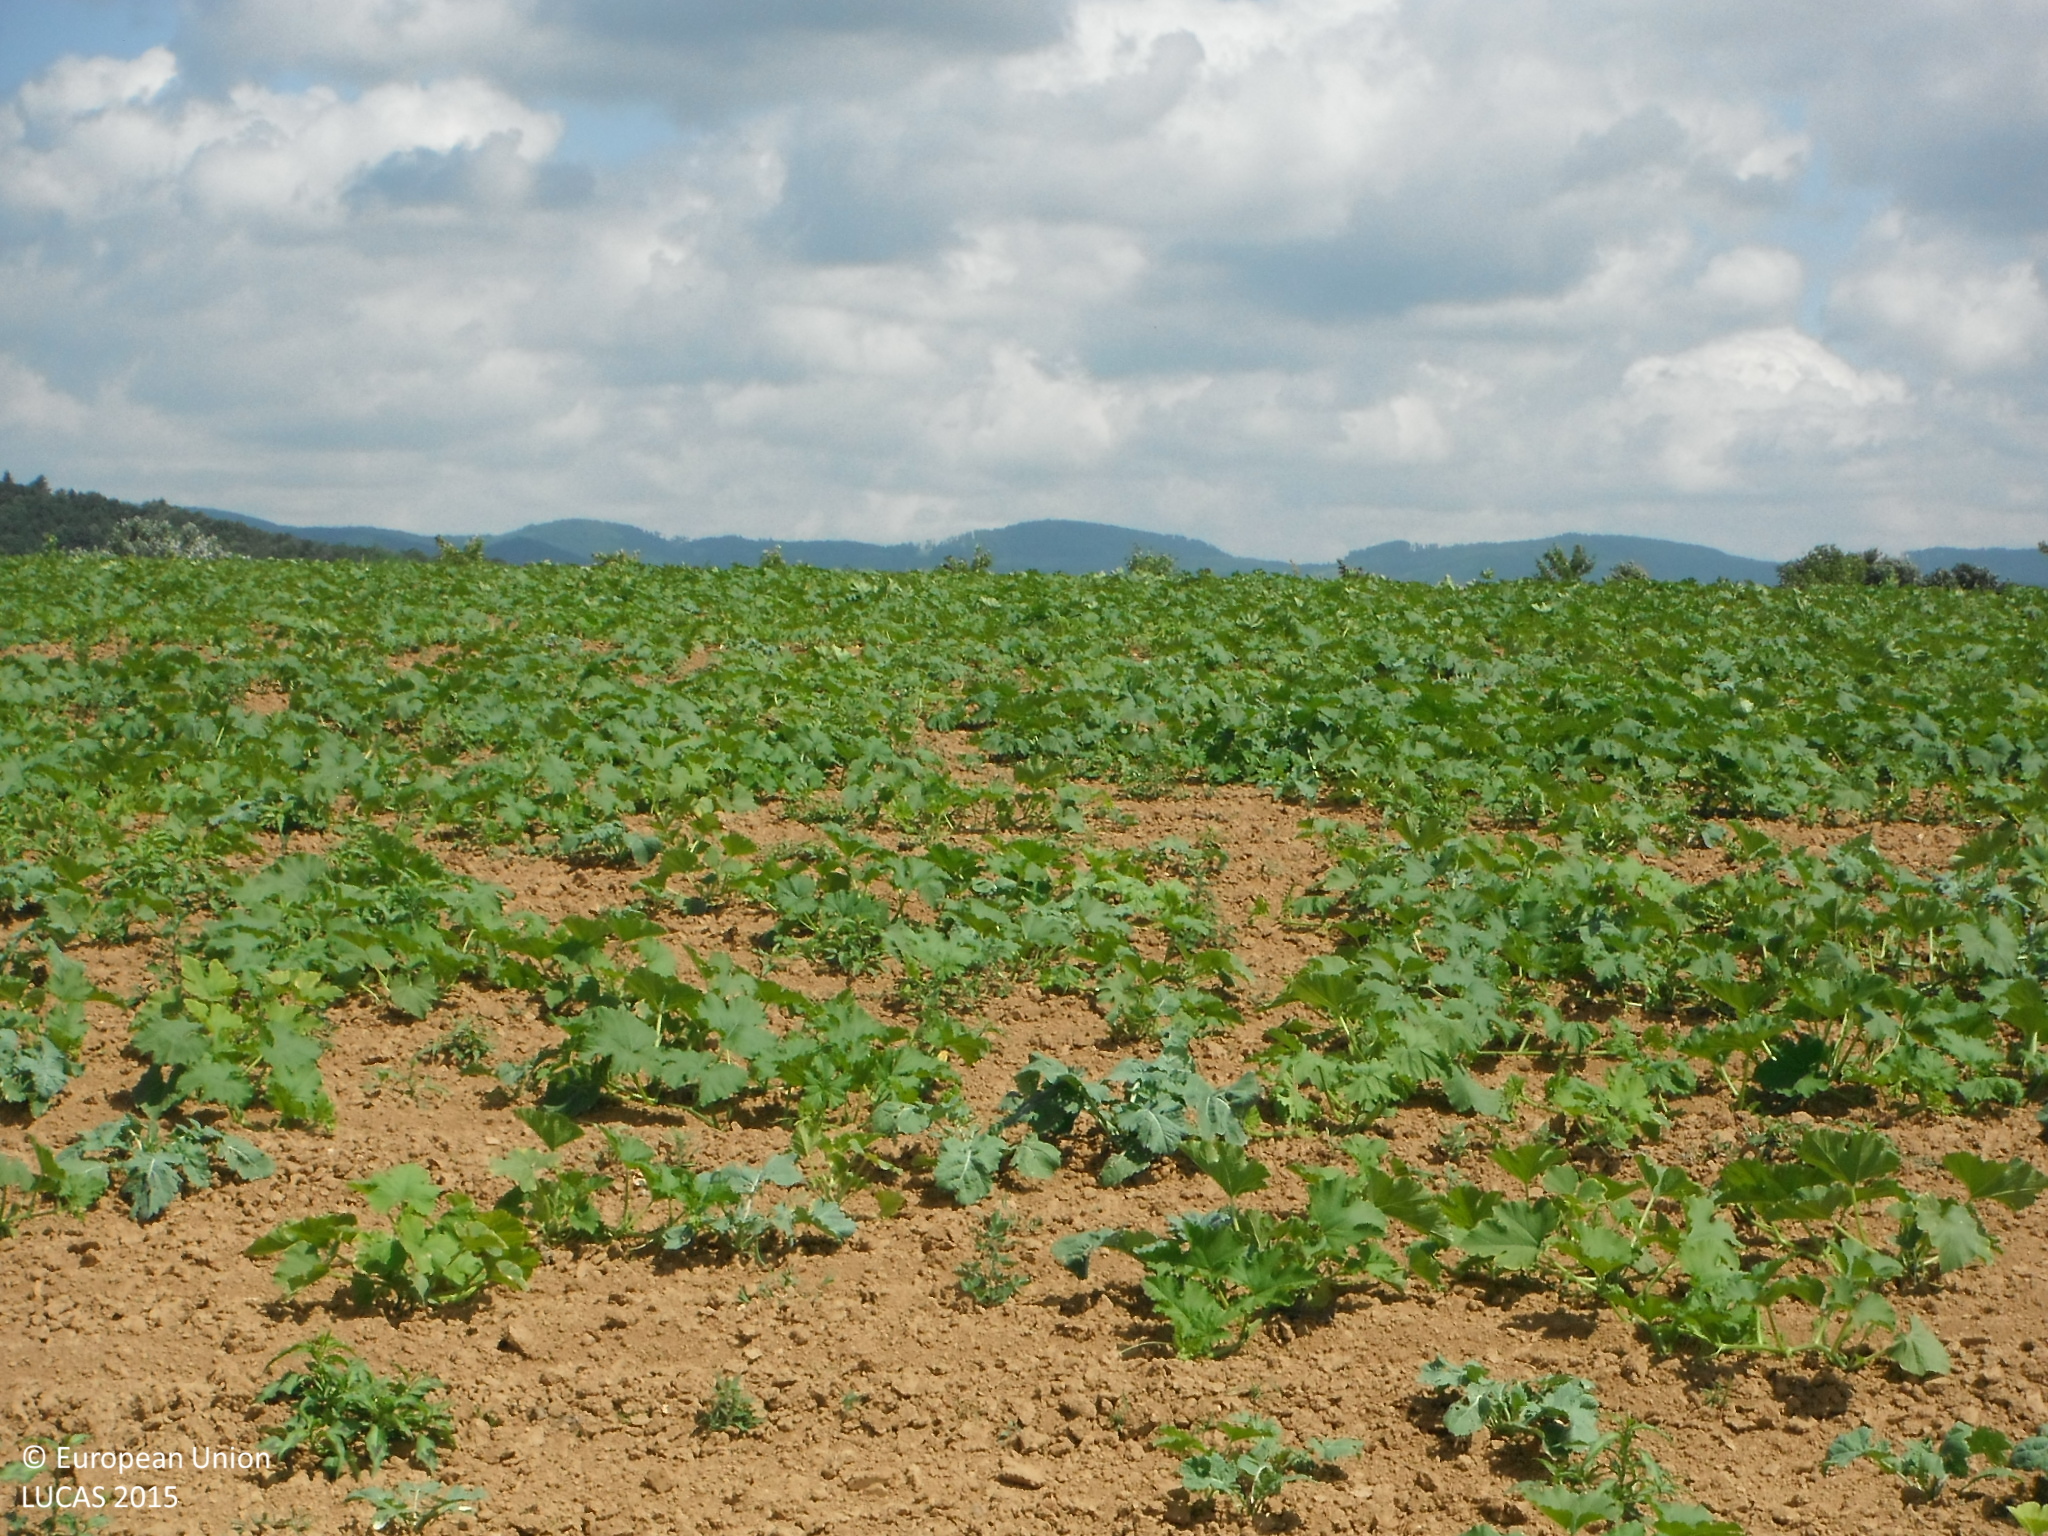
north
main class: Cropland
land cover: Other fresh vegetables
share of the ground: 25 - 50 %
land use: Agriculture (excluding fallow land and kitchen gardens)
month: June
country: SK
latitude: 48.3989
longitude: 18.2949
